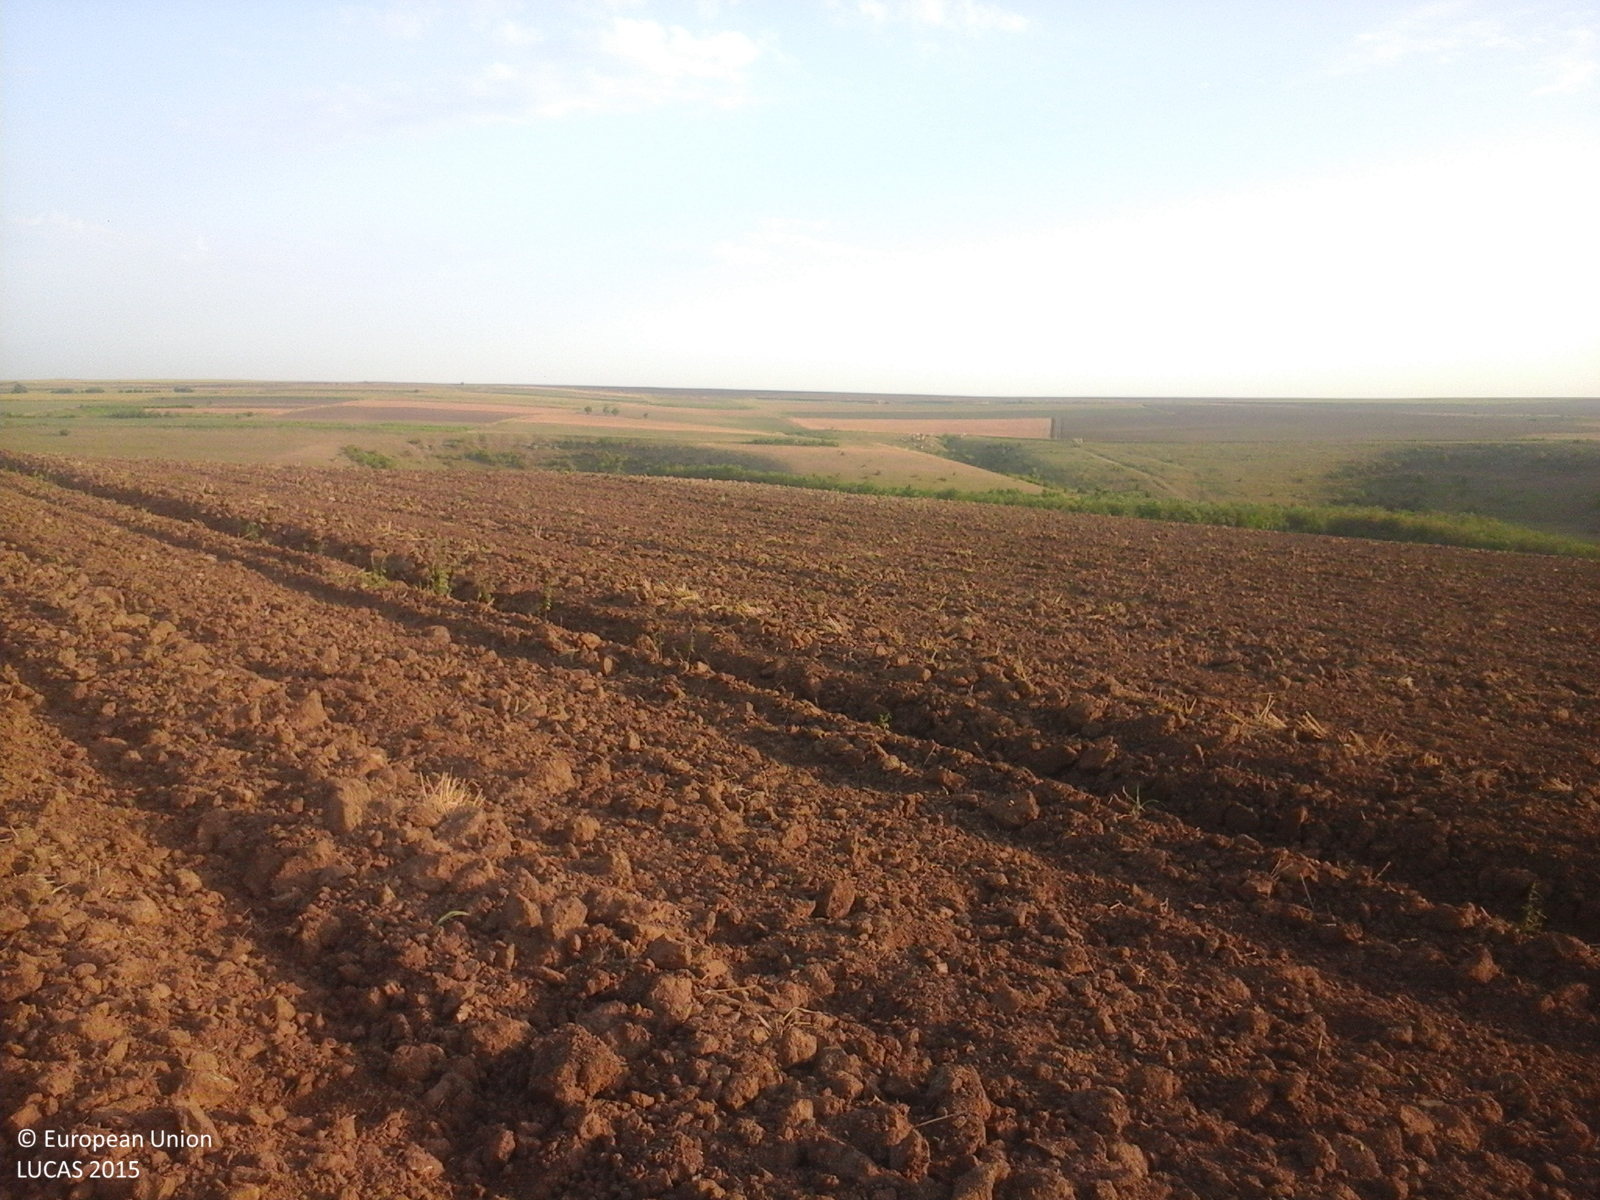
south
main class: Cropland
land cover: Common wheat
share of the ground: < 10 %
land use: Agriculture (excluding fallow land and kitchen gardens)
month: August
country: RO
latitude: 43.9665
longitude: 28.0640
